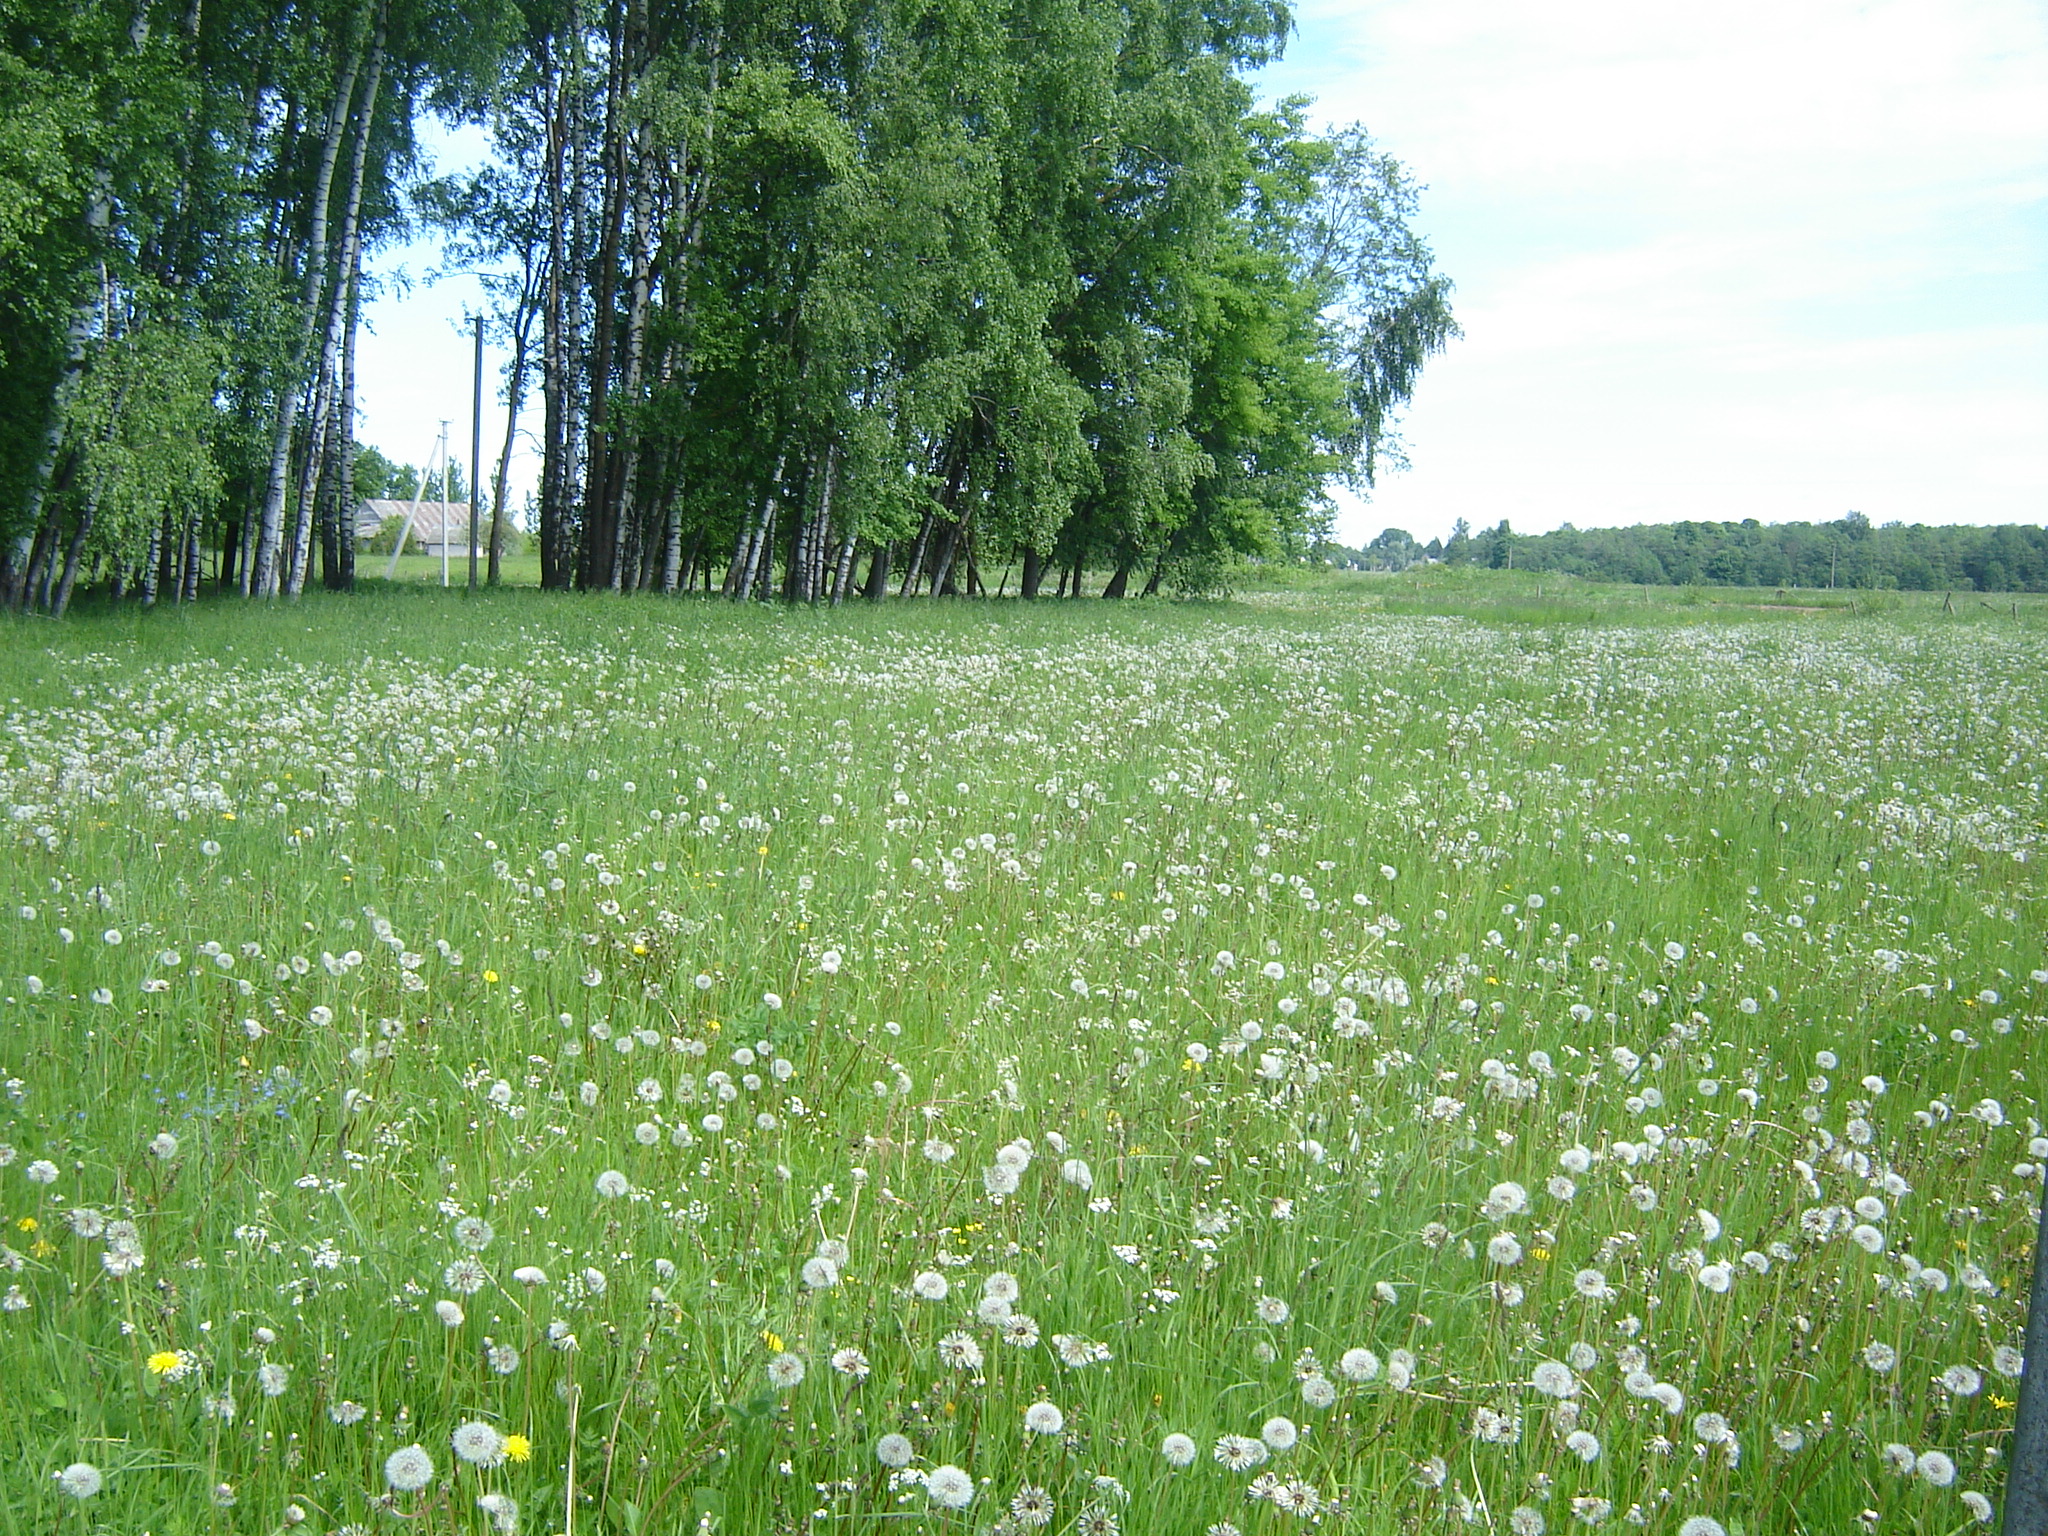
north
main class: Grassland
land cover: Grassland without tree/shrub cover
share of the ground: > 75 %
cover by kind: herbaceous plants 100 %
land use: Agriculture (excluding fallow land and kitchen gardens)
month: May
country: LT
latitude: 55.8321
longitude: 25.1374
